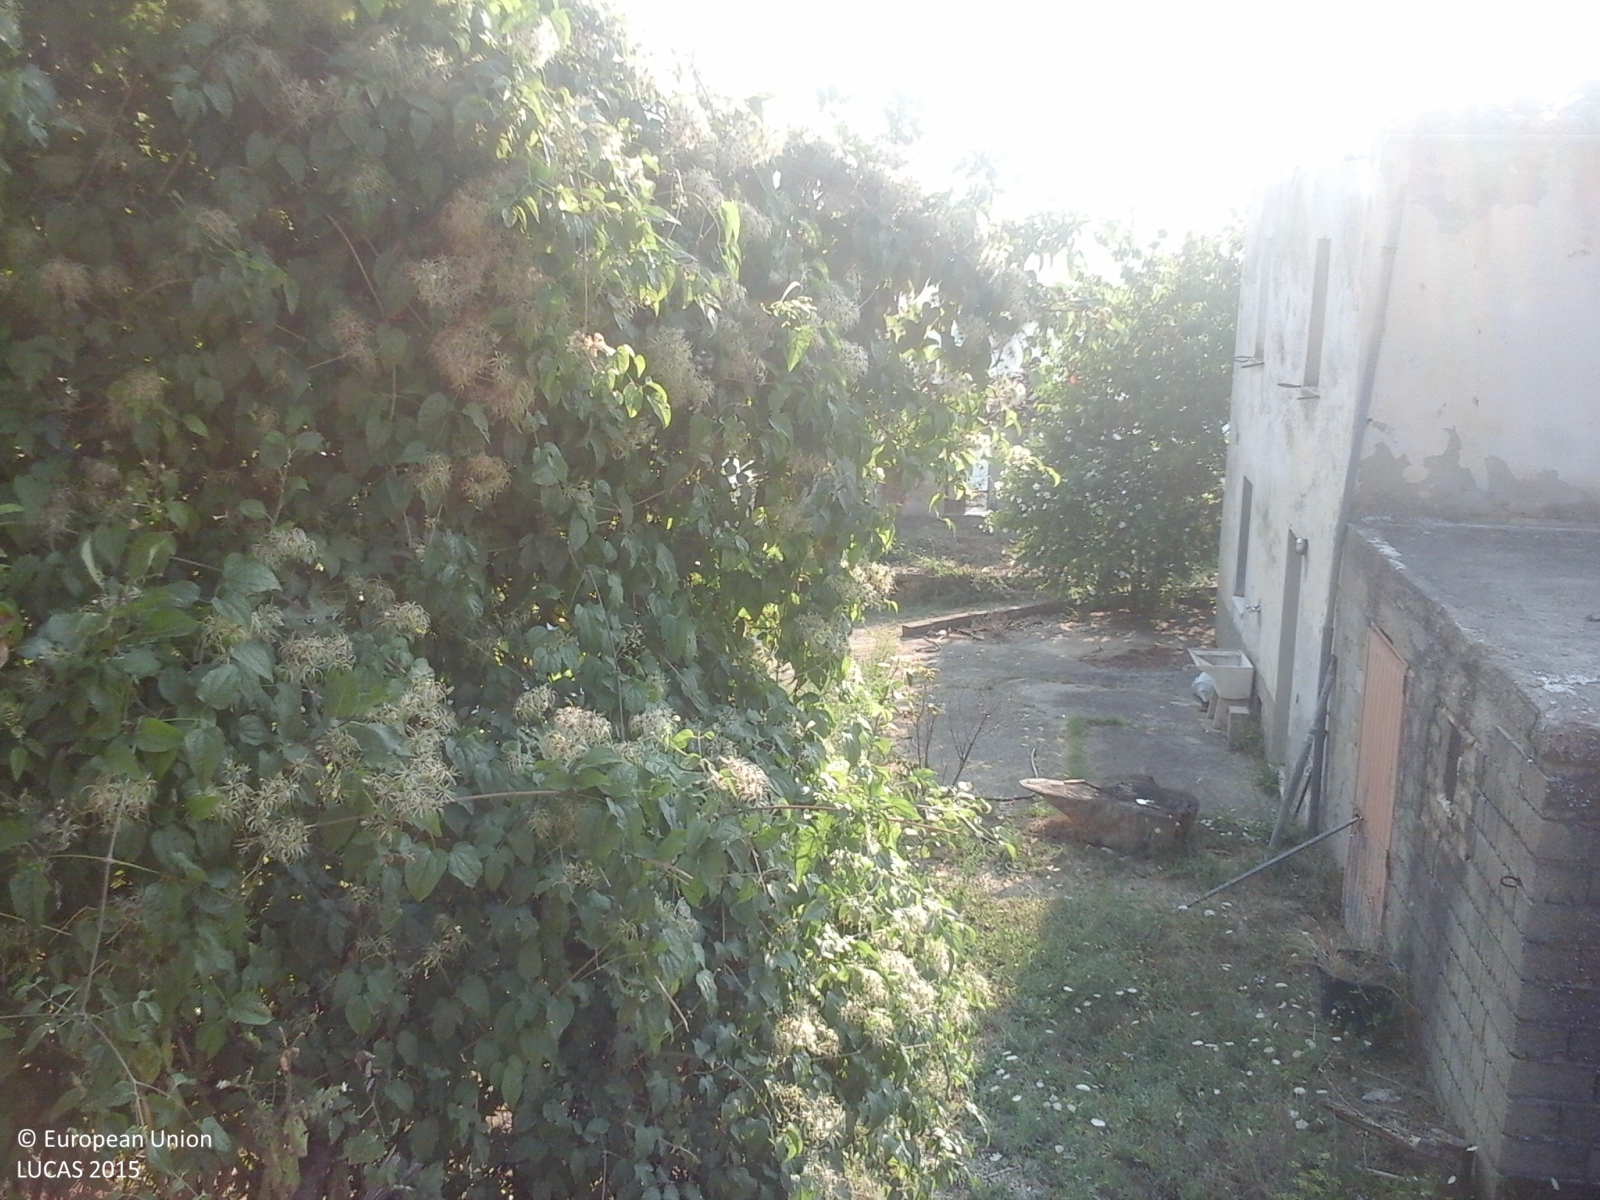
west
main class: Cropland
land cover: Mixed cereals for fodder
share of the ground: > 75 %
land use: Agriculture (excluding fallow land and kitchen gardens)
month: August
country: IT
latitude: 42.4744
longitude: 13.7957
